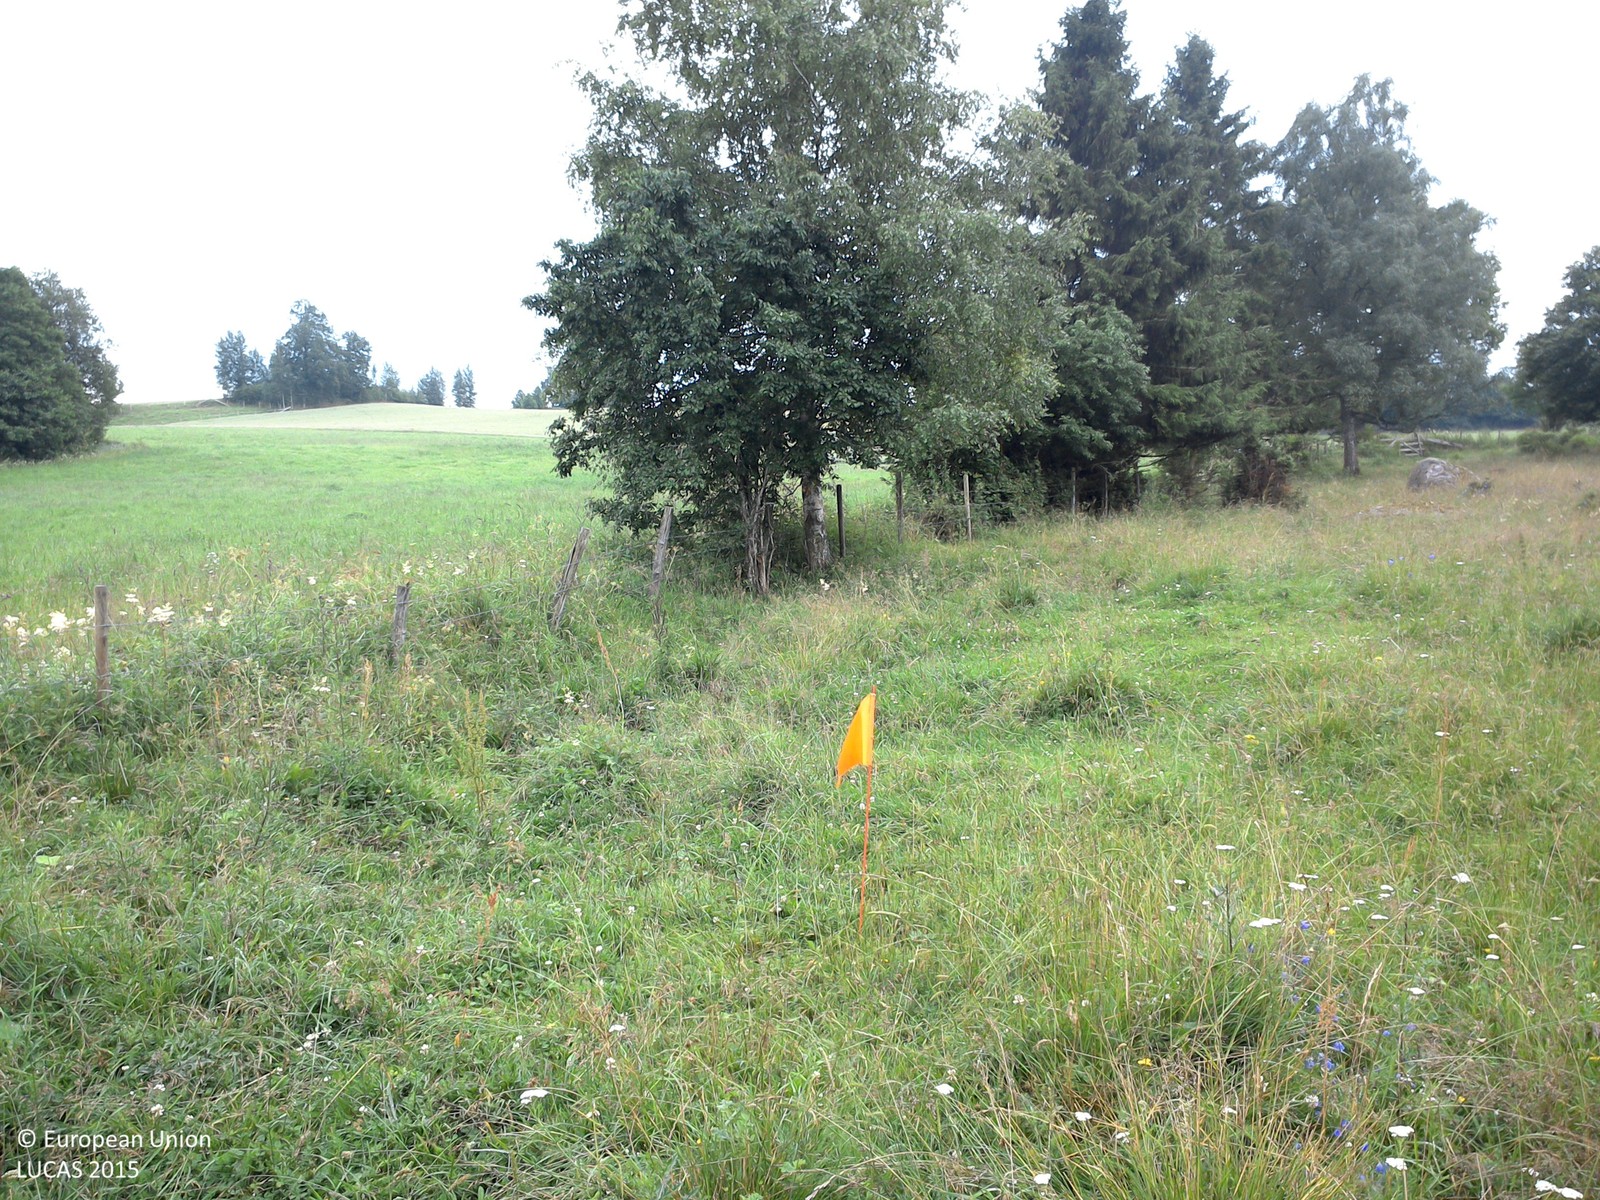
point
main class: Grassland
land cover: Grassland without tree/shrub cover
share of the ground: > 75 %
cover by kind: herbaceous plants 100 %
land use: Agriculture (excluding fallow land and kitchen gardens)
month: July
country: SE
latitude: 58.2903
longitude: 14.9580
